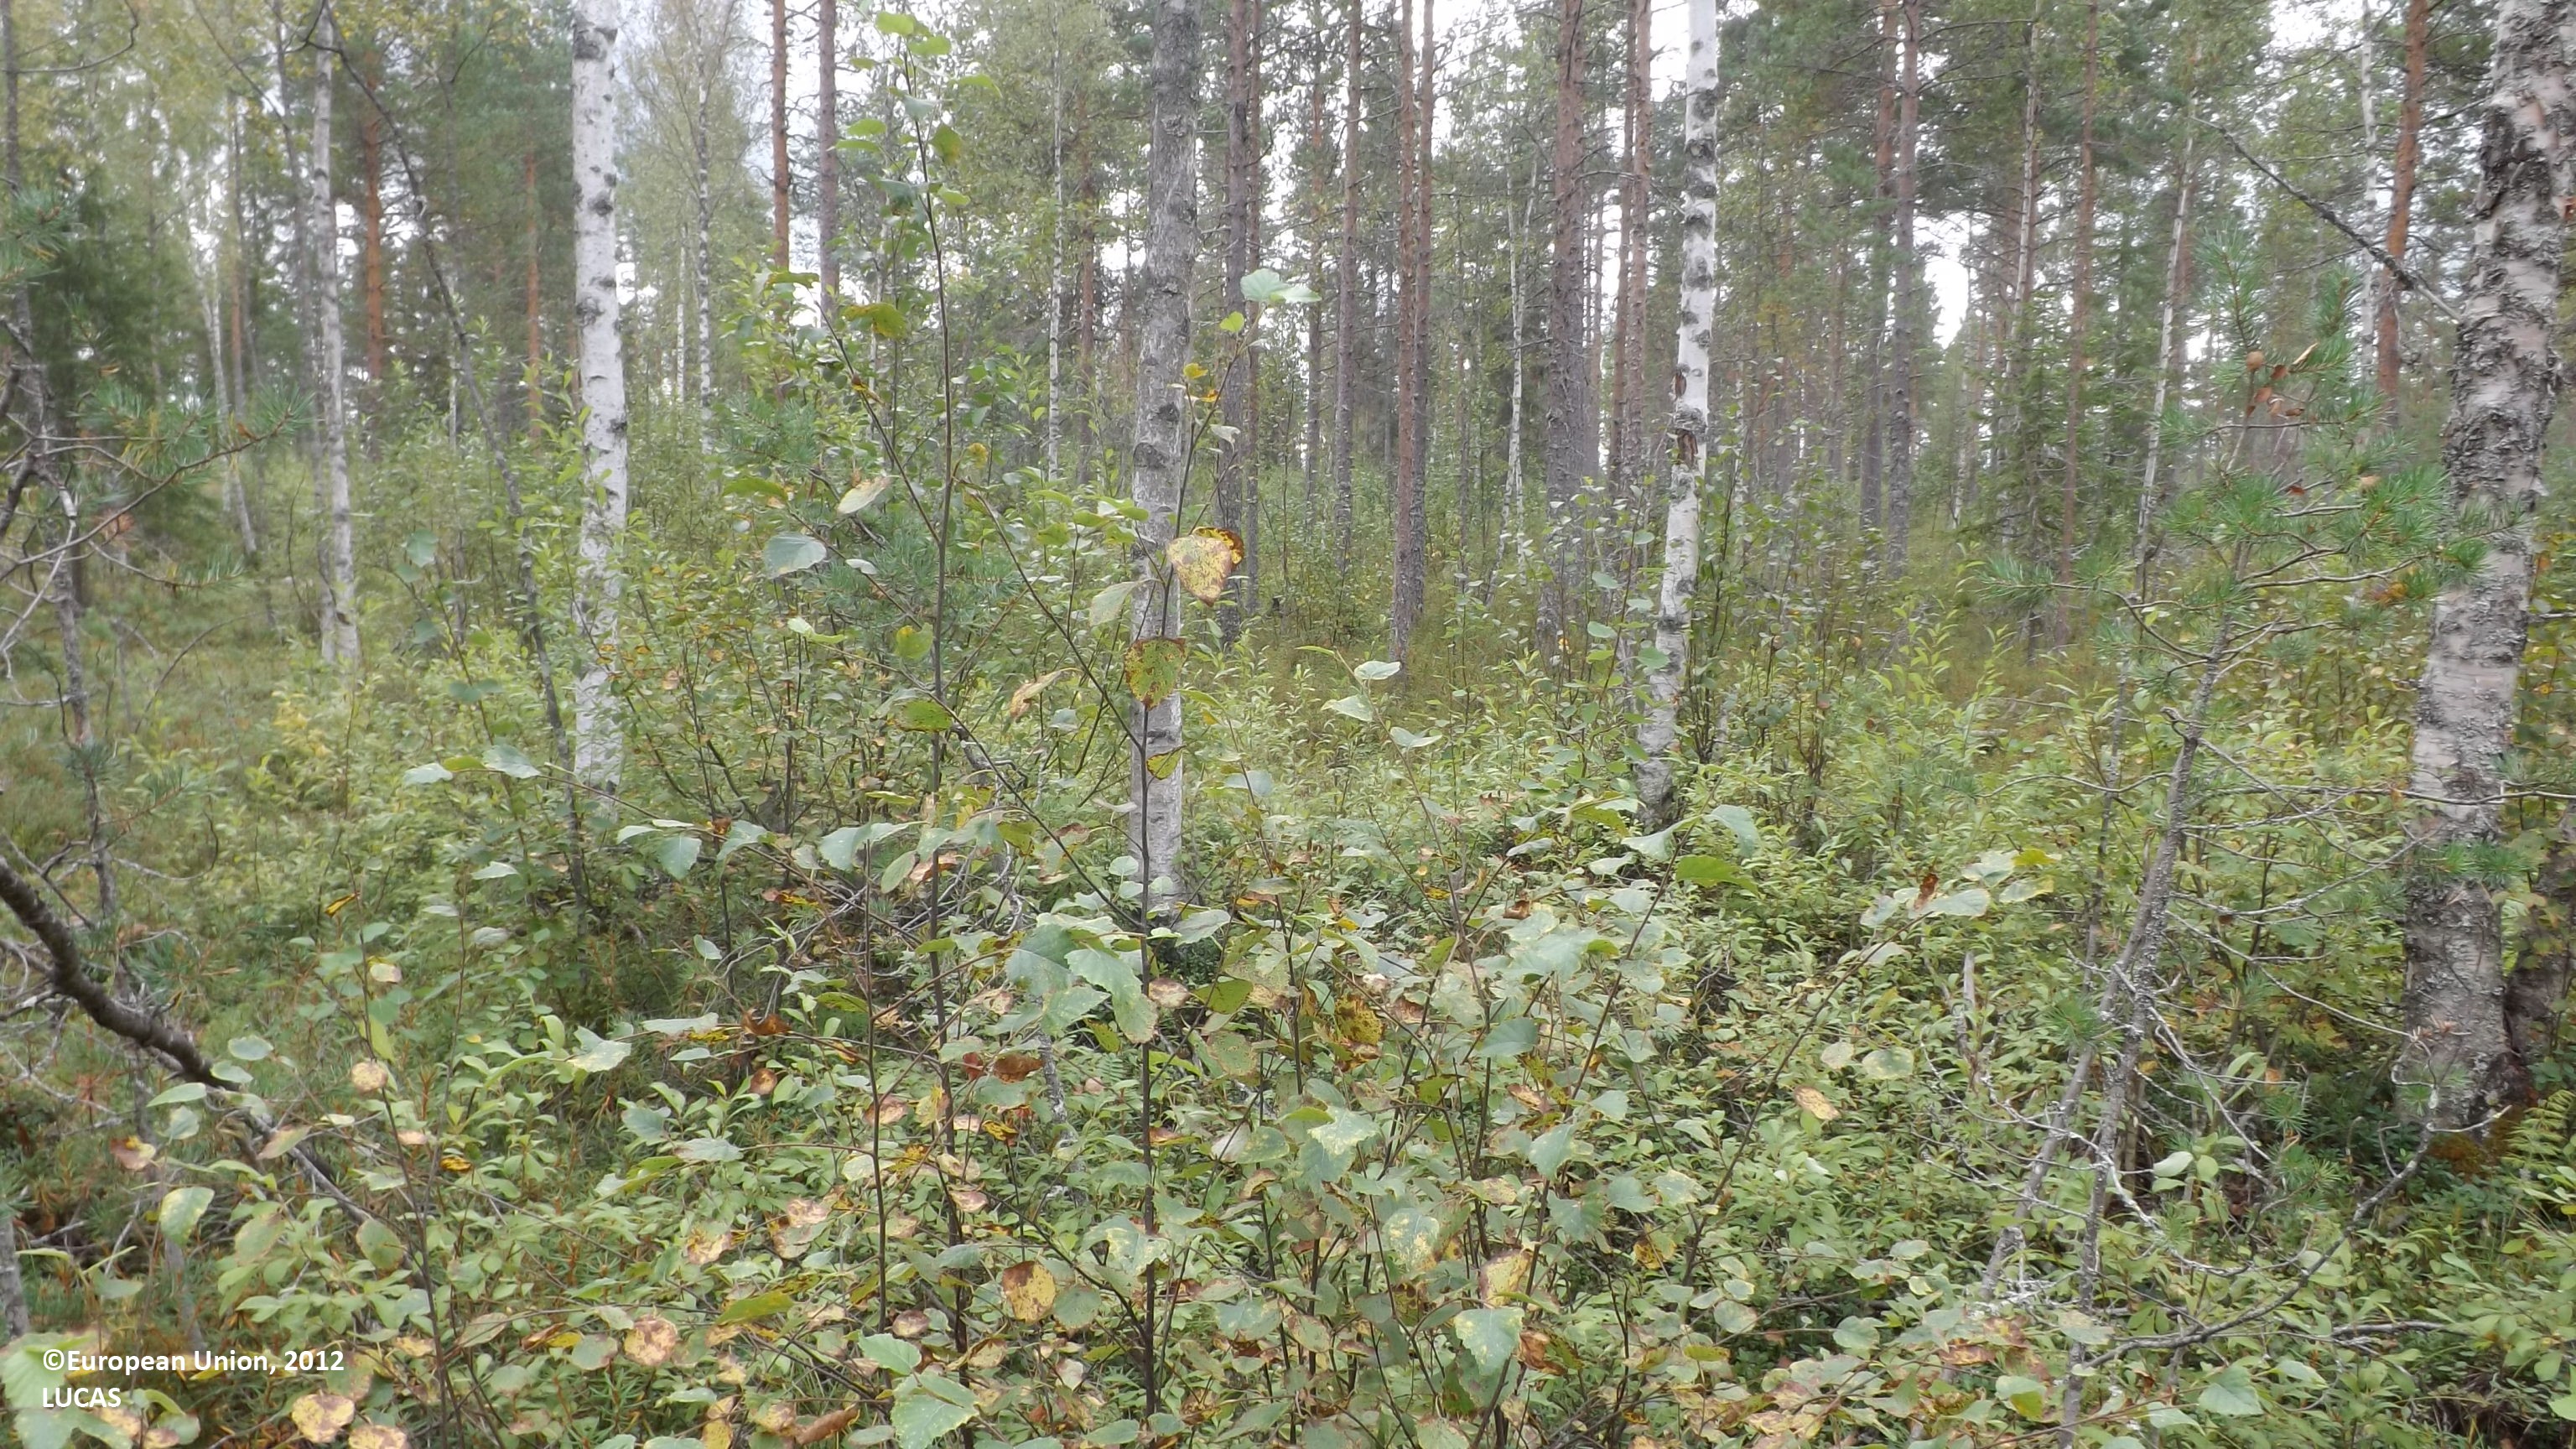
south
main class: Woodland
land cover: Pine dominated mixed woodland
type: boreal forest
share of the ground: 25 - 50 %
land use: Forestry
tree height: > 5 m
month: August
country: FI
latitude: 63.8646
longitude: 24.2122
